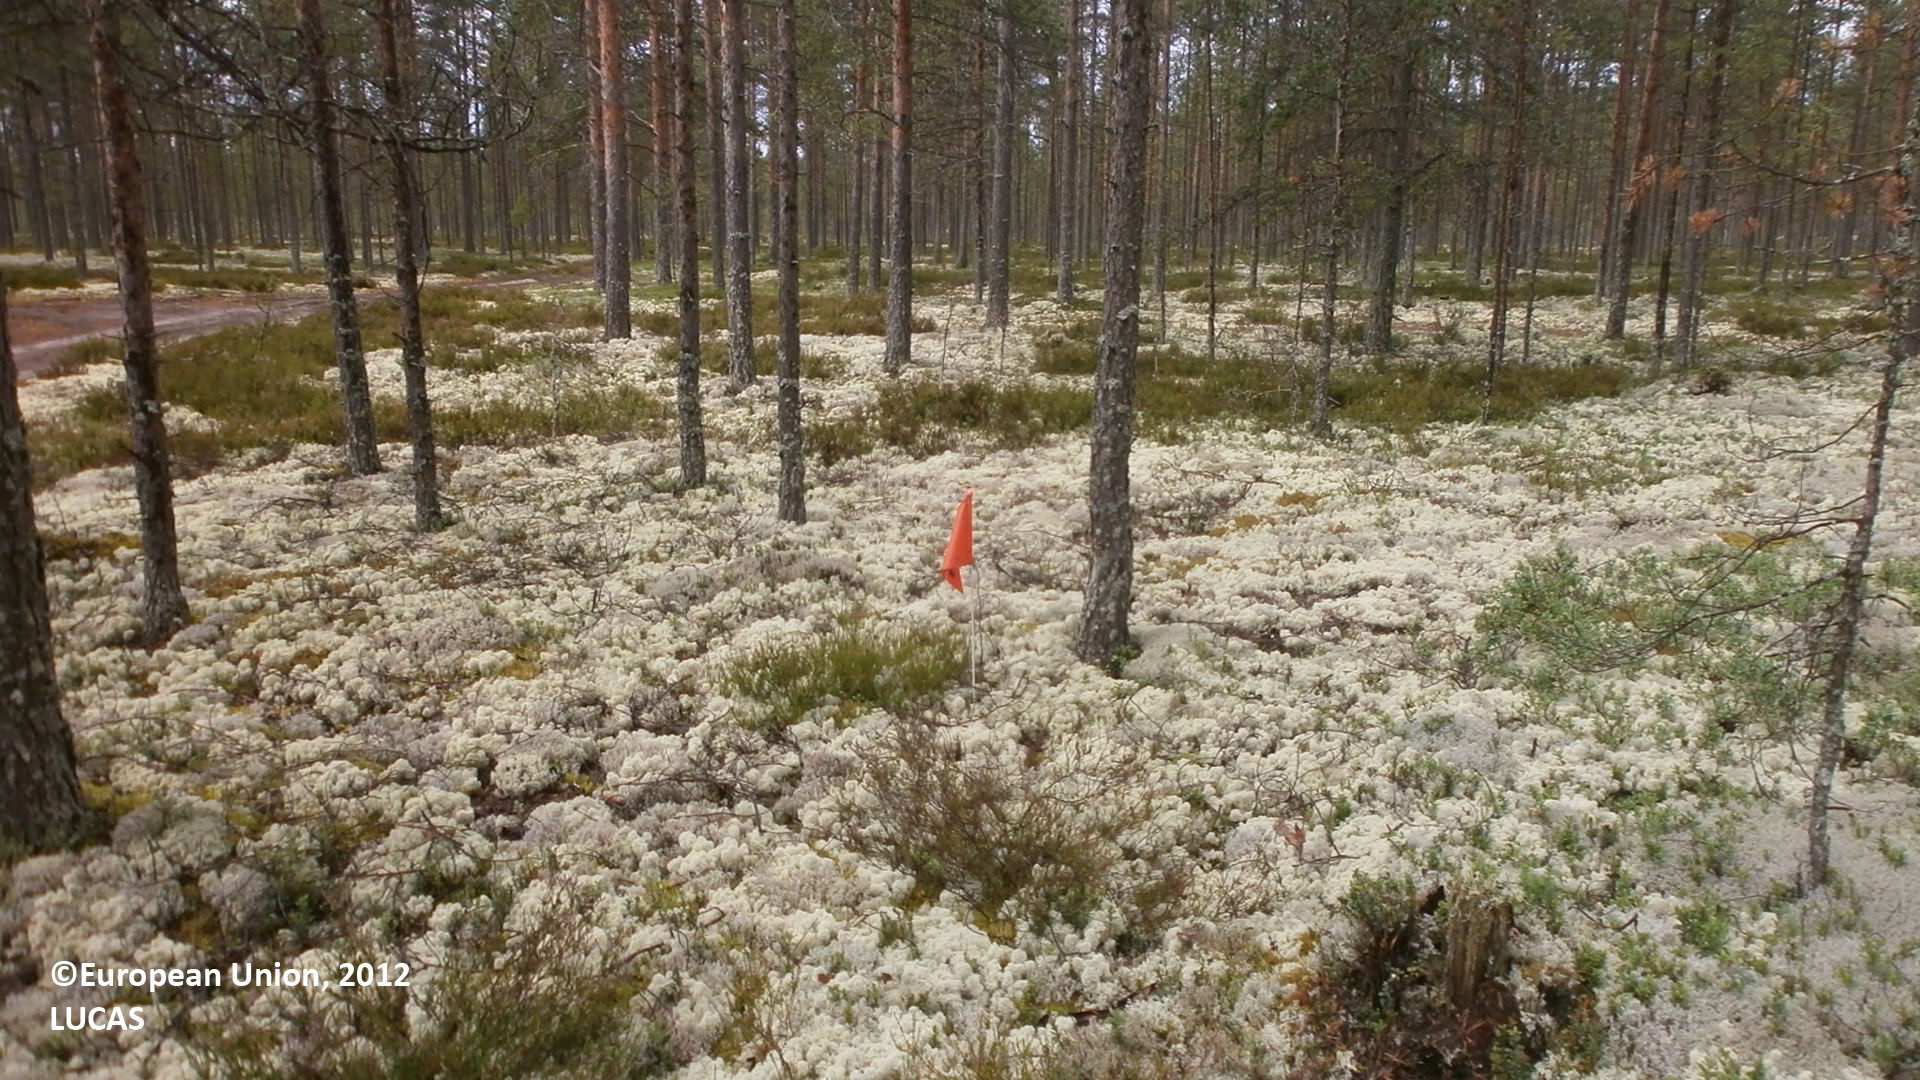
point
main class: Woodland
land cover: Pine dominated coniferous woodland
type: boreal forest
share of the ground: 50 - 75 %
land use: Forestry
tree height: > 5 m
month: July
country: FI
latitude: 64.1368
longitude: 23.8479
